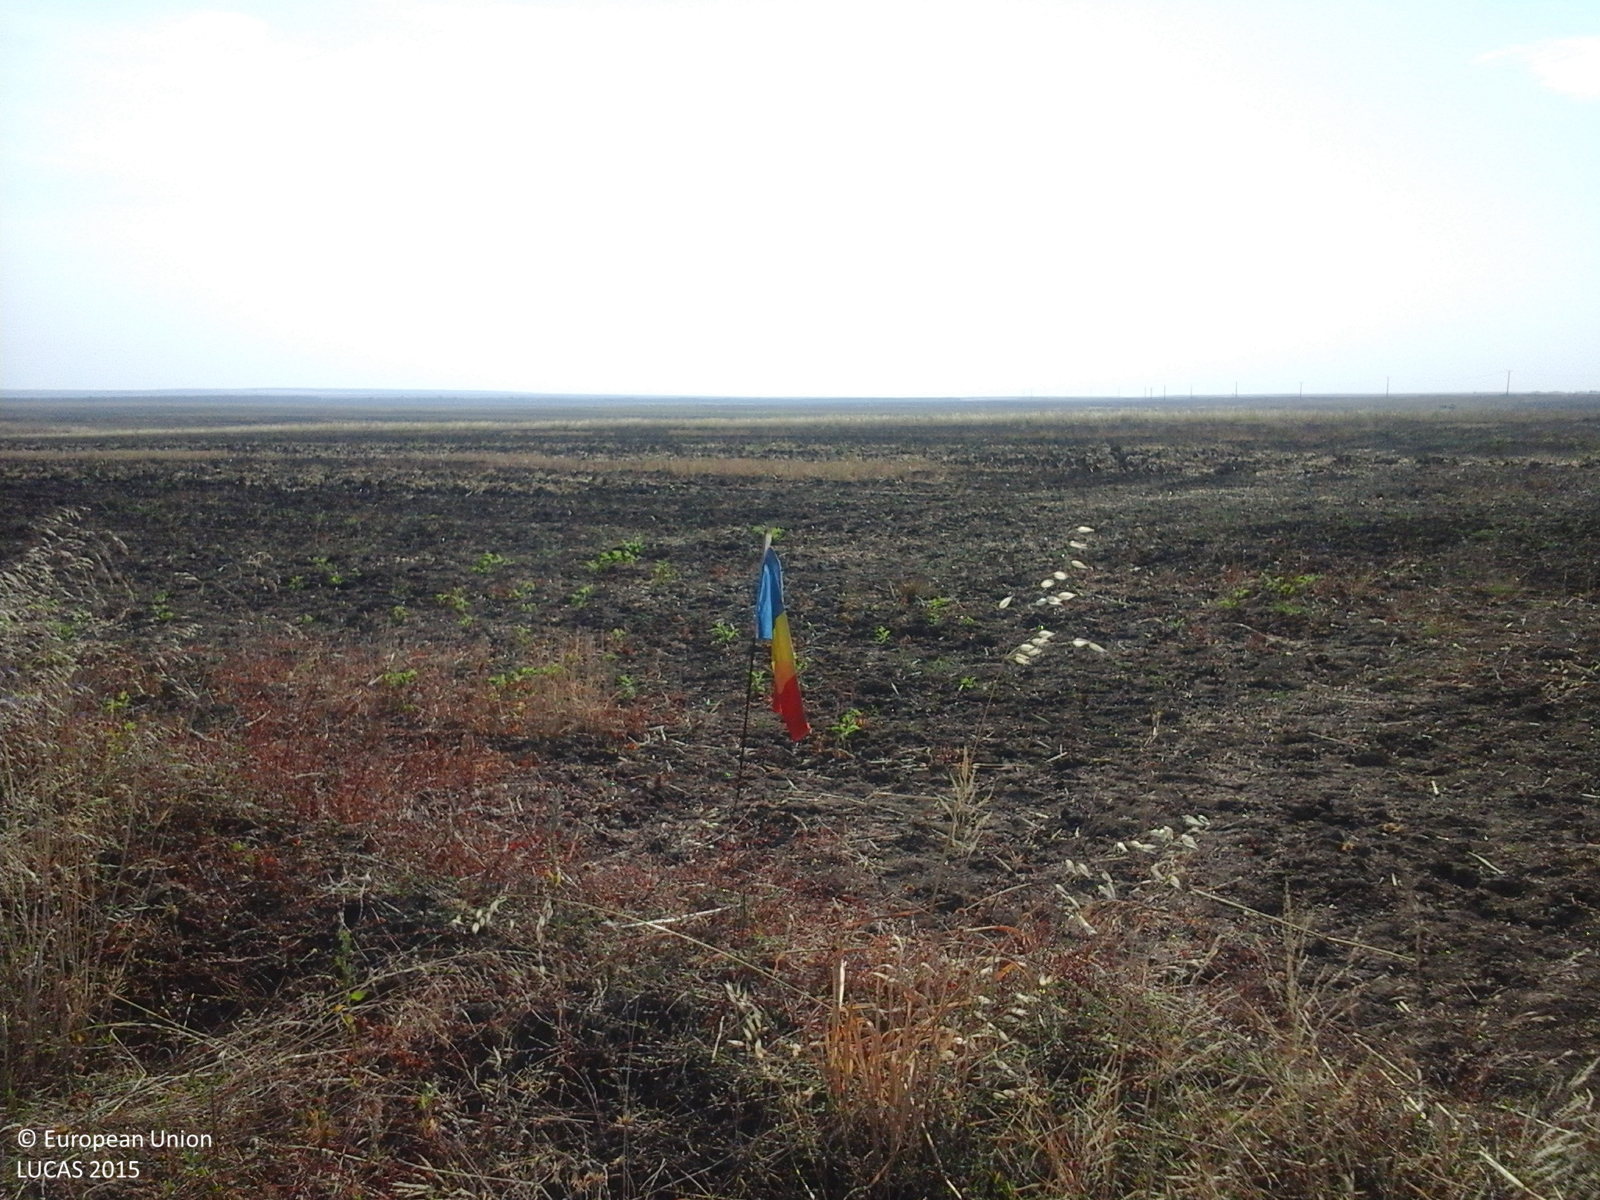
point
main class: Cropland
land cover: Common wheat
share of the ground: < 10 %
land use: Agriculture (excluding fallow land and kitchen gardens)
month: August
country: RO
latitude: 44.2224
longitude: 22.9991
